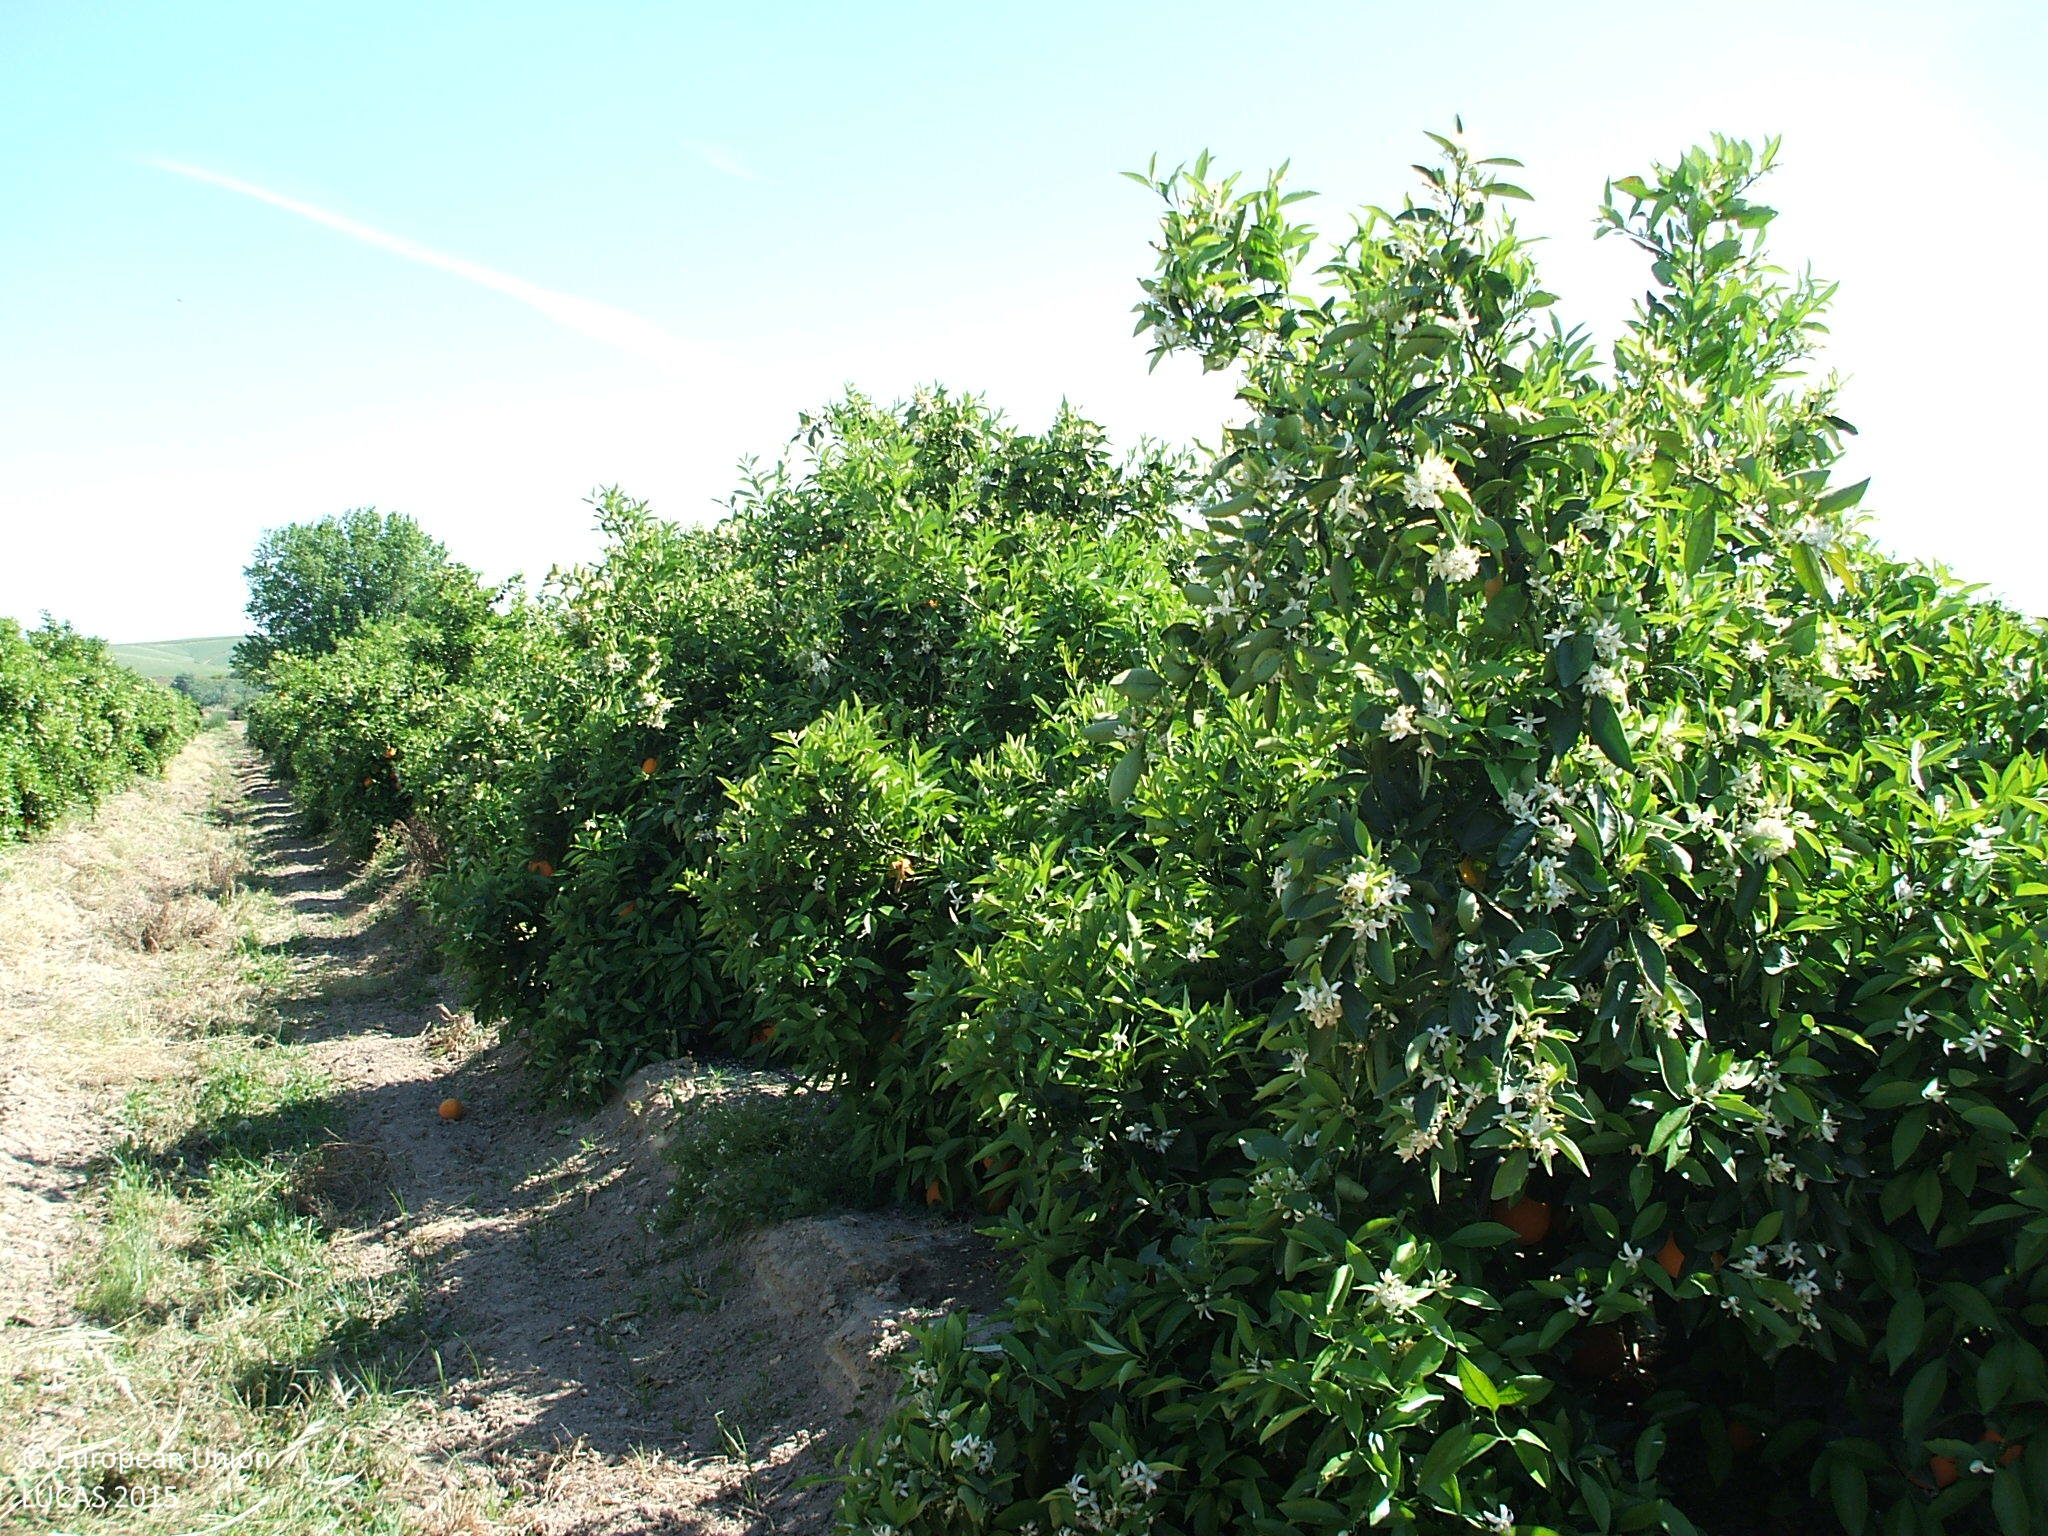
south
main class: Cropland
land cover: Oranges
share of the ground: 10 - 25 %
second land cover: Spontaneously vegetated surfaces
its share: 25 - 50 %
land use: Agriculture (excluding fallow land and kitchen gardens)
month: April
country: ES
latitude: 37.6558
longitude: -5.4471
